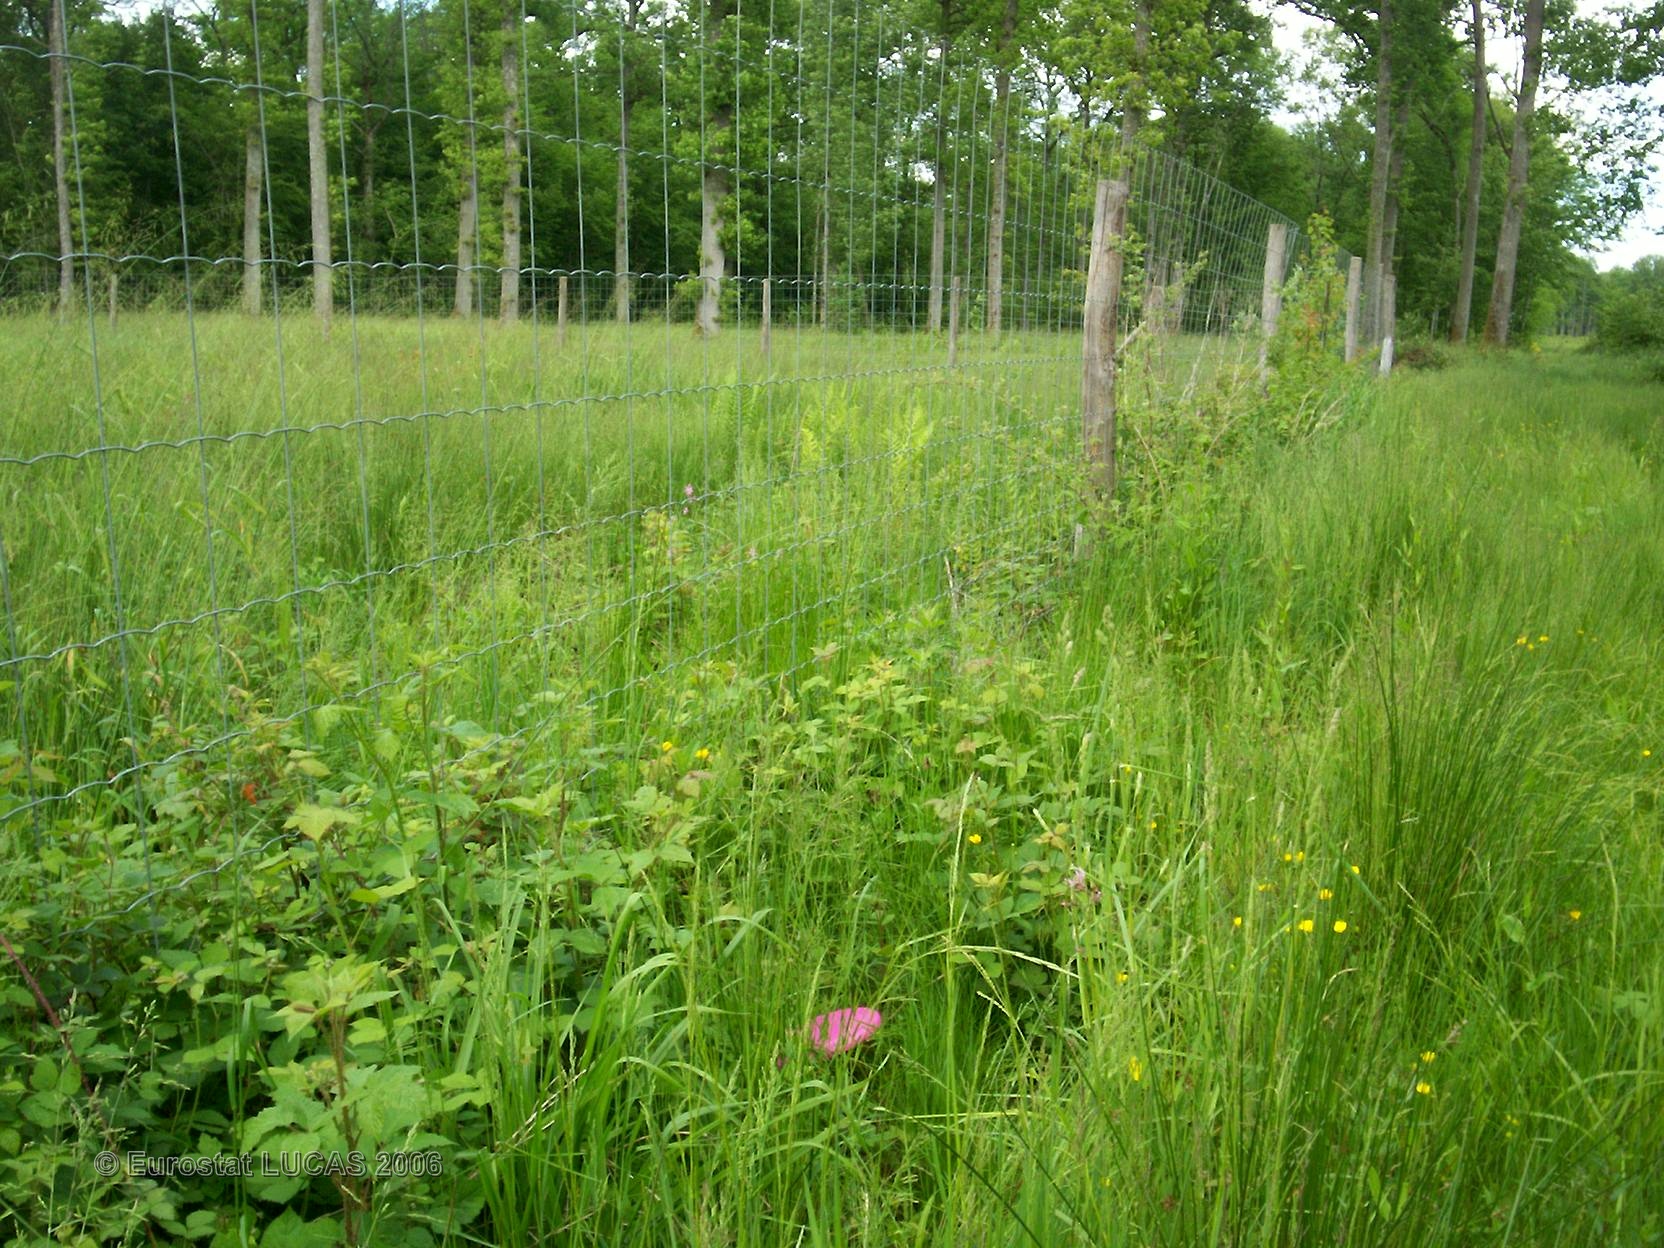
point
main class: Grassland
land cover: Grassland without tree/shrub cover
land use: Agriculture (excluding fallow land and kitchen gardens)
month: May
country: FR
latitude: 48.3650
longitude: 4.6662
